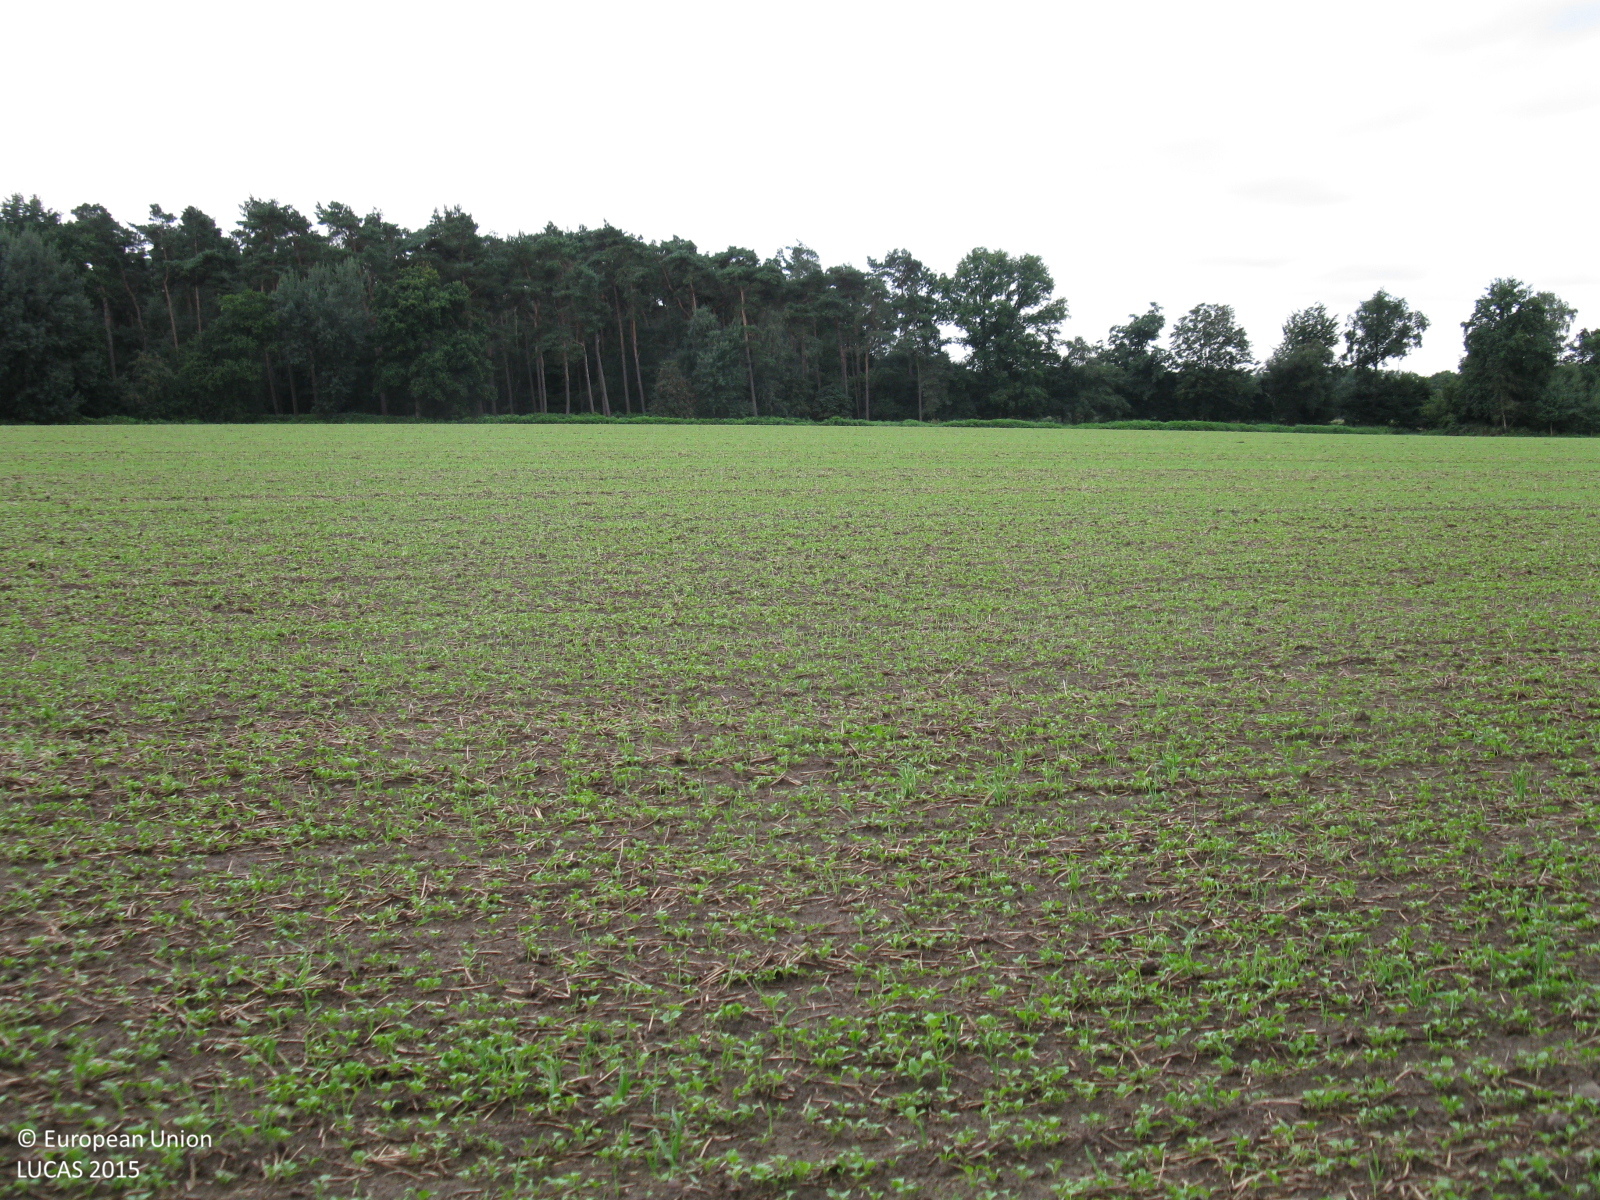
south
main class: Cropland
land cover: Rye
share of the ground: 10 - 25 %
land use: Agriculture (excluding fallow land and kitchen gardens)
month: August
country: DE
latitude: 51.7296
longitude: 7.0609
